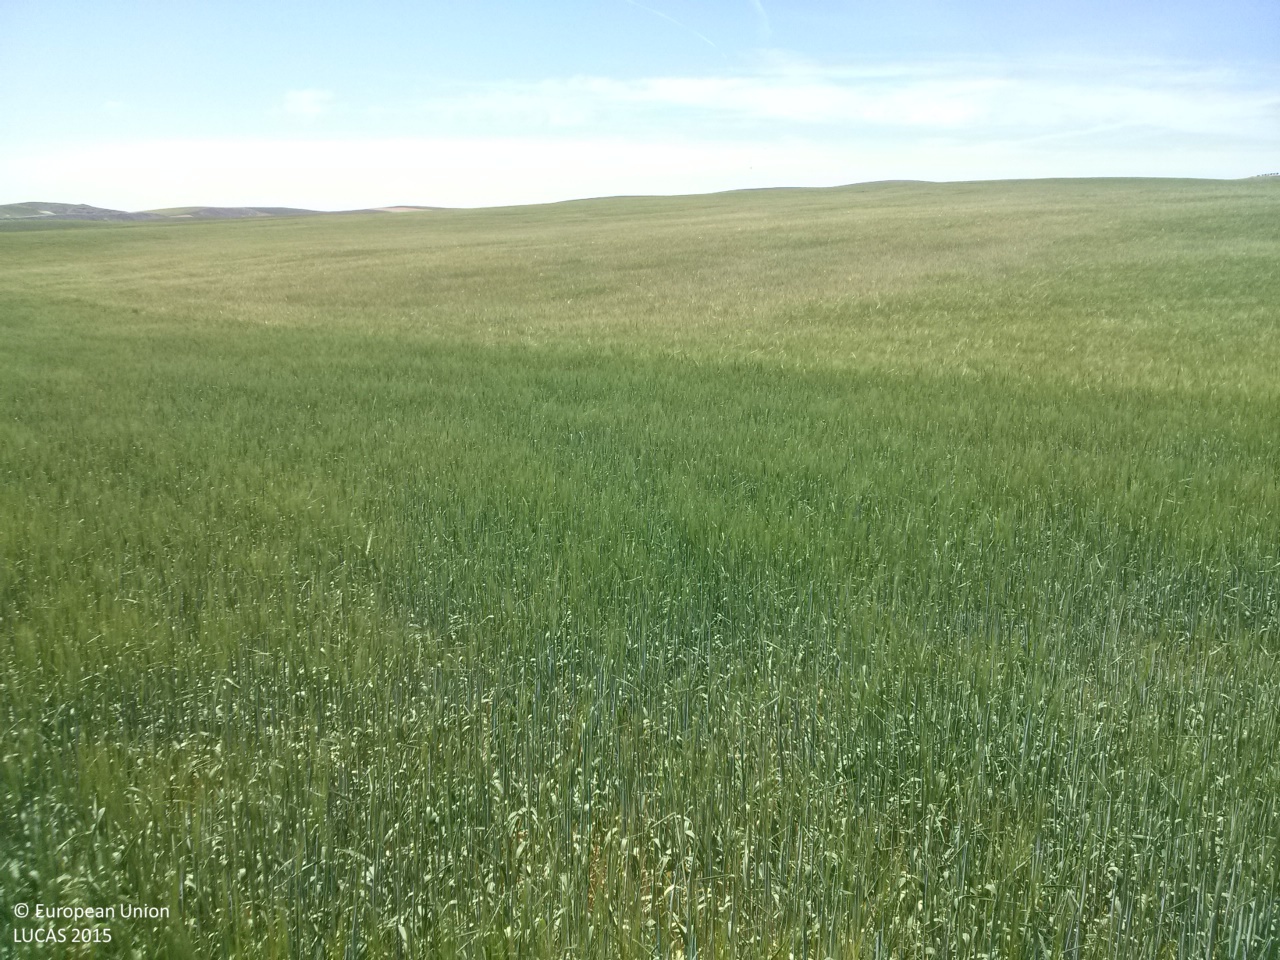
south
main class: Cropland
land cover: Barley
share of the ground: > 75 %
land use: Agriculture (excluding fallow land and kitchen gardens)
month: May
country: ES
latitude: 39.9598
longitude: -2.7689
